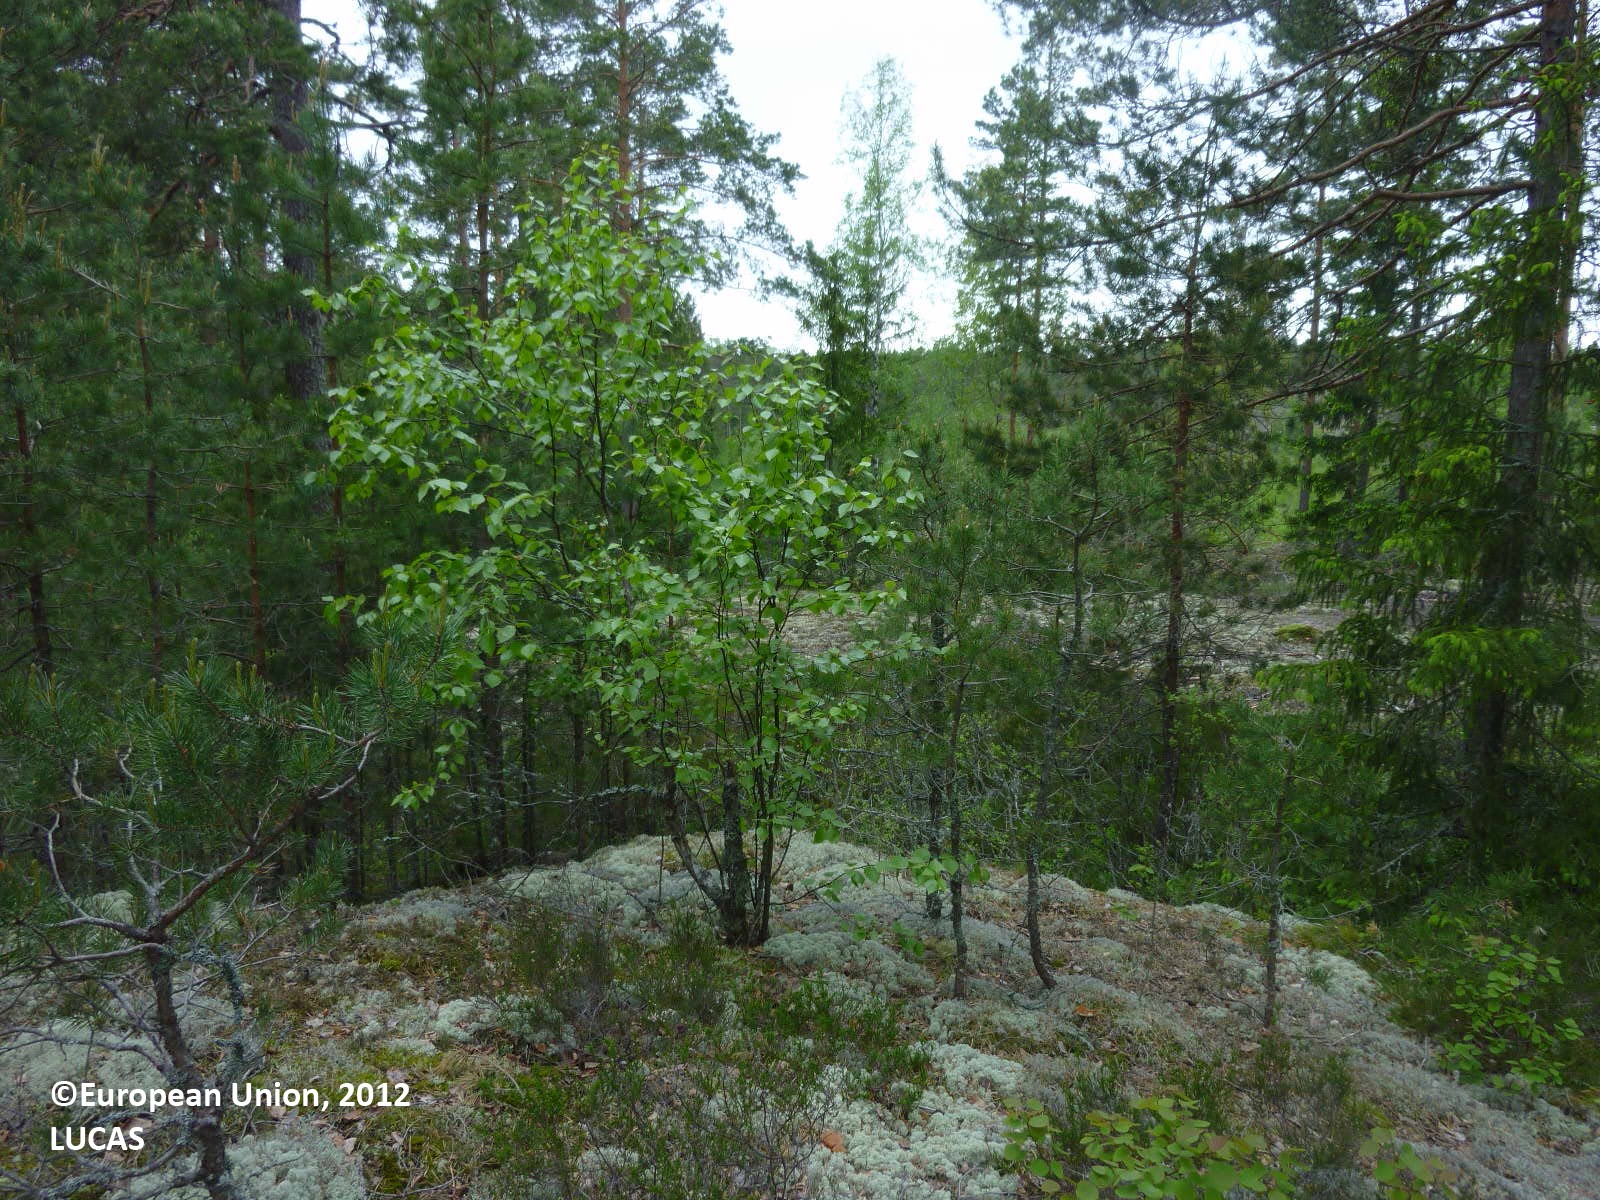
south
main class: Woodland
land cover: Pine dominated coniferous woodland
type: boreal forest
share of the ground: 25 - 50 %
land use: Forestry
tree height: > 5 m
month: June
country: FI
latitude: 60.3763
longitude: 22.6417
